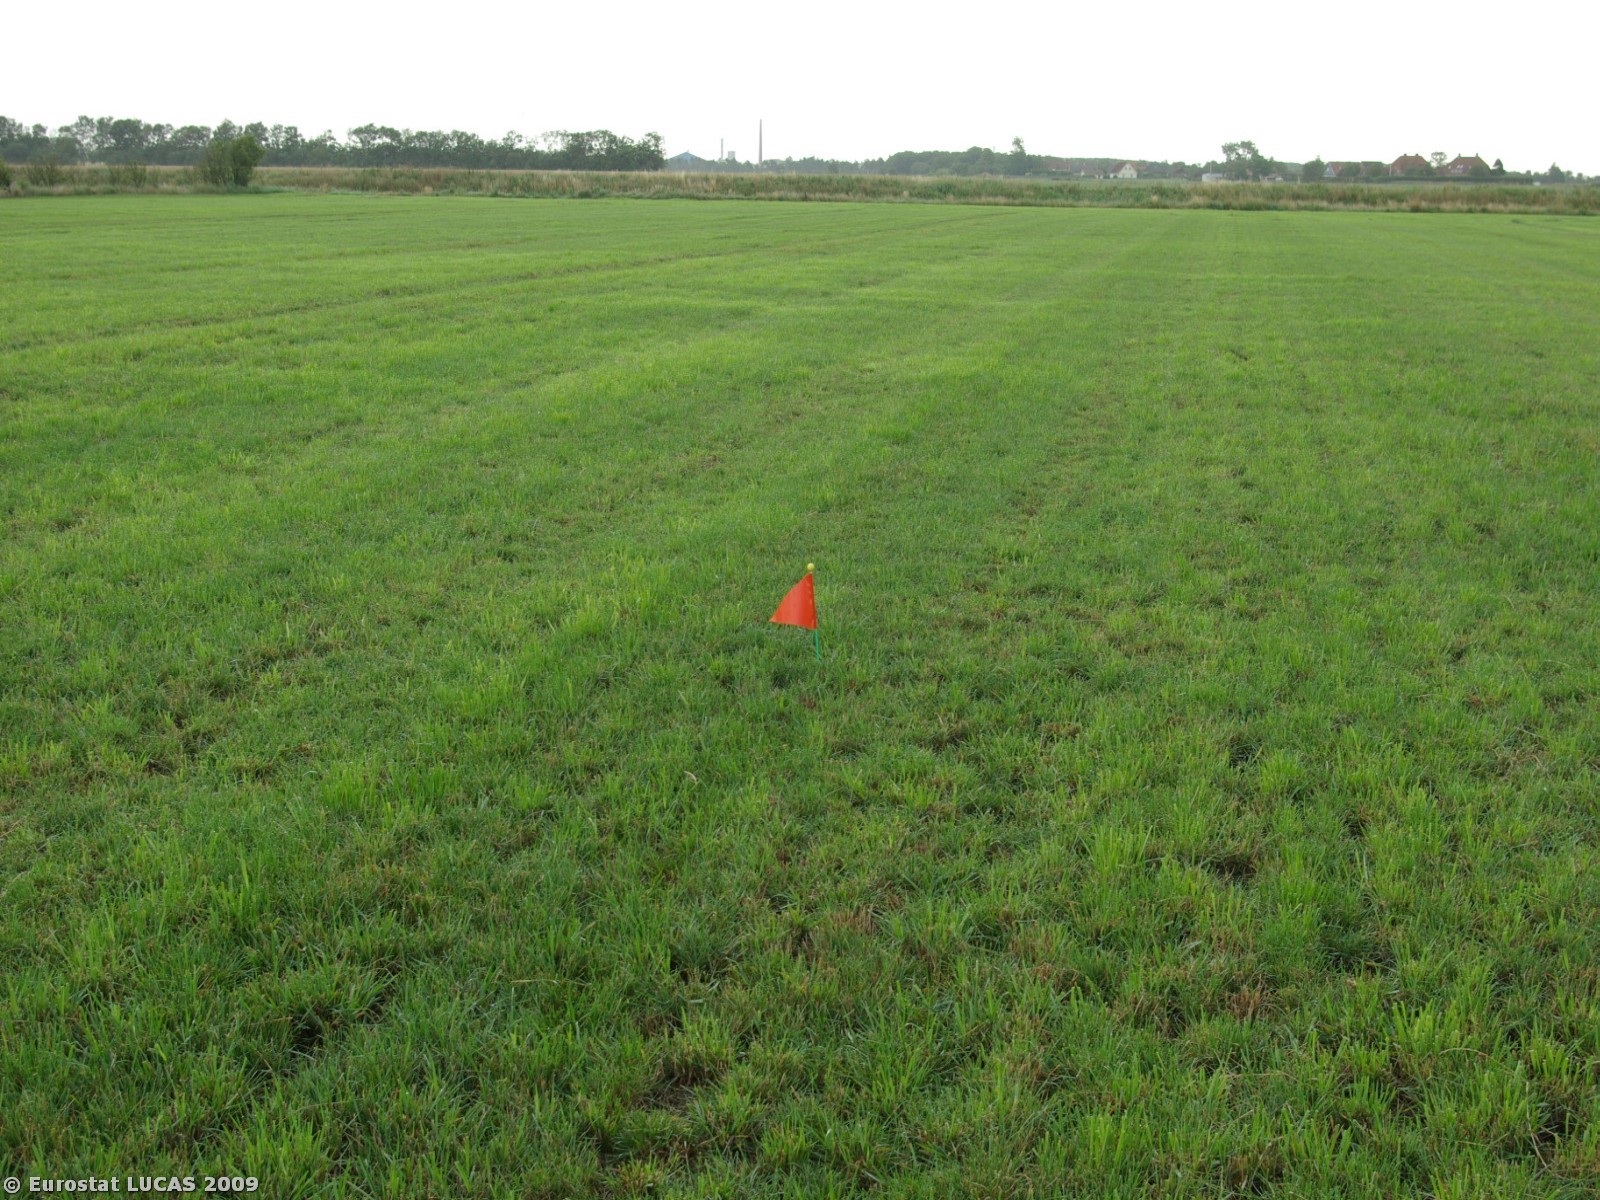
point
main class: Grassland
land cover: Grassland without tree/shrub cover
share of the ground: > 75 %
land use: Agriculture (excluding fallow land and kitchen gardens)
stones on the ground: < 10 %
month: July
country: DK
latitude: 54.9241
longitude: 8.8306
